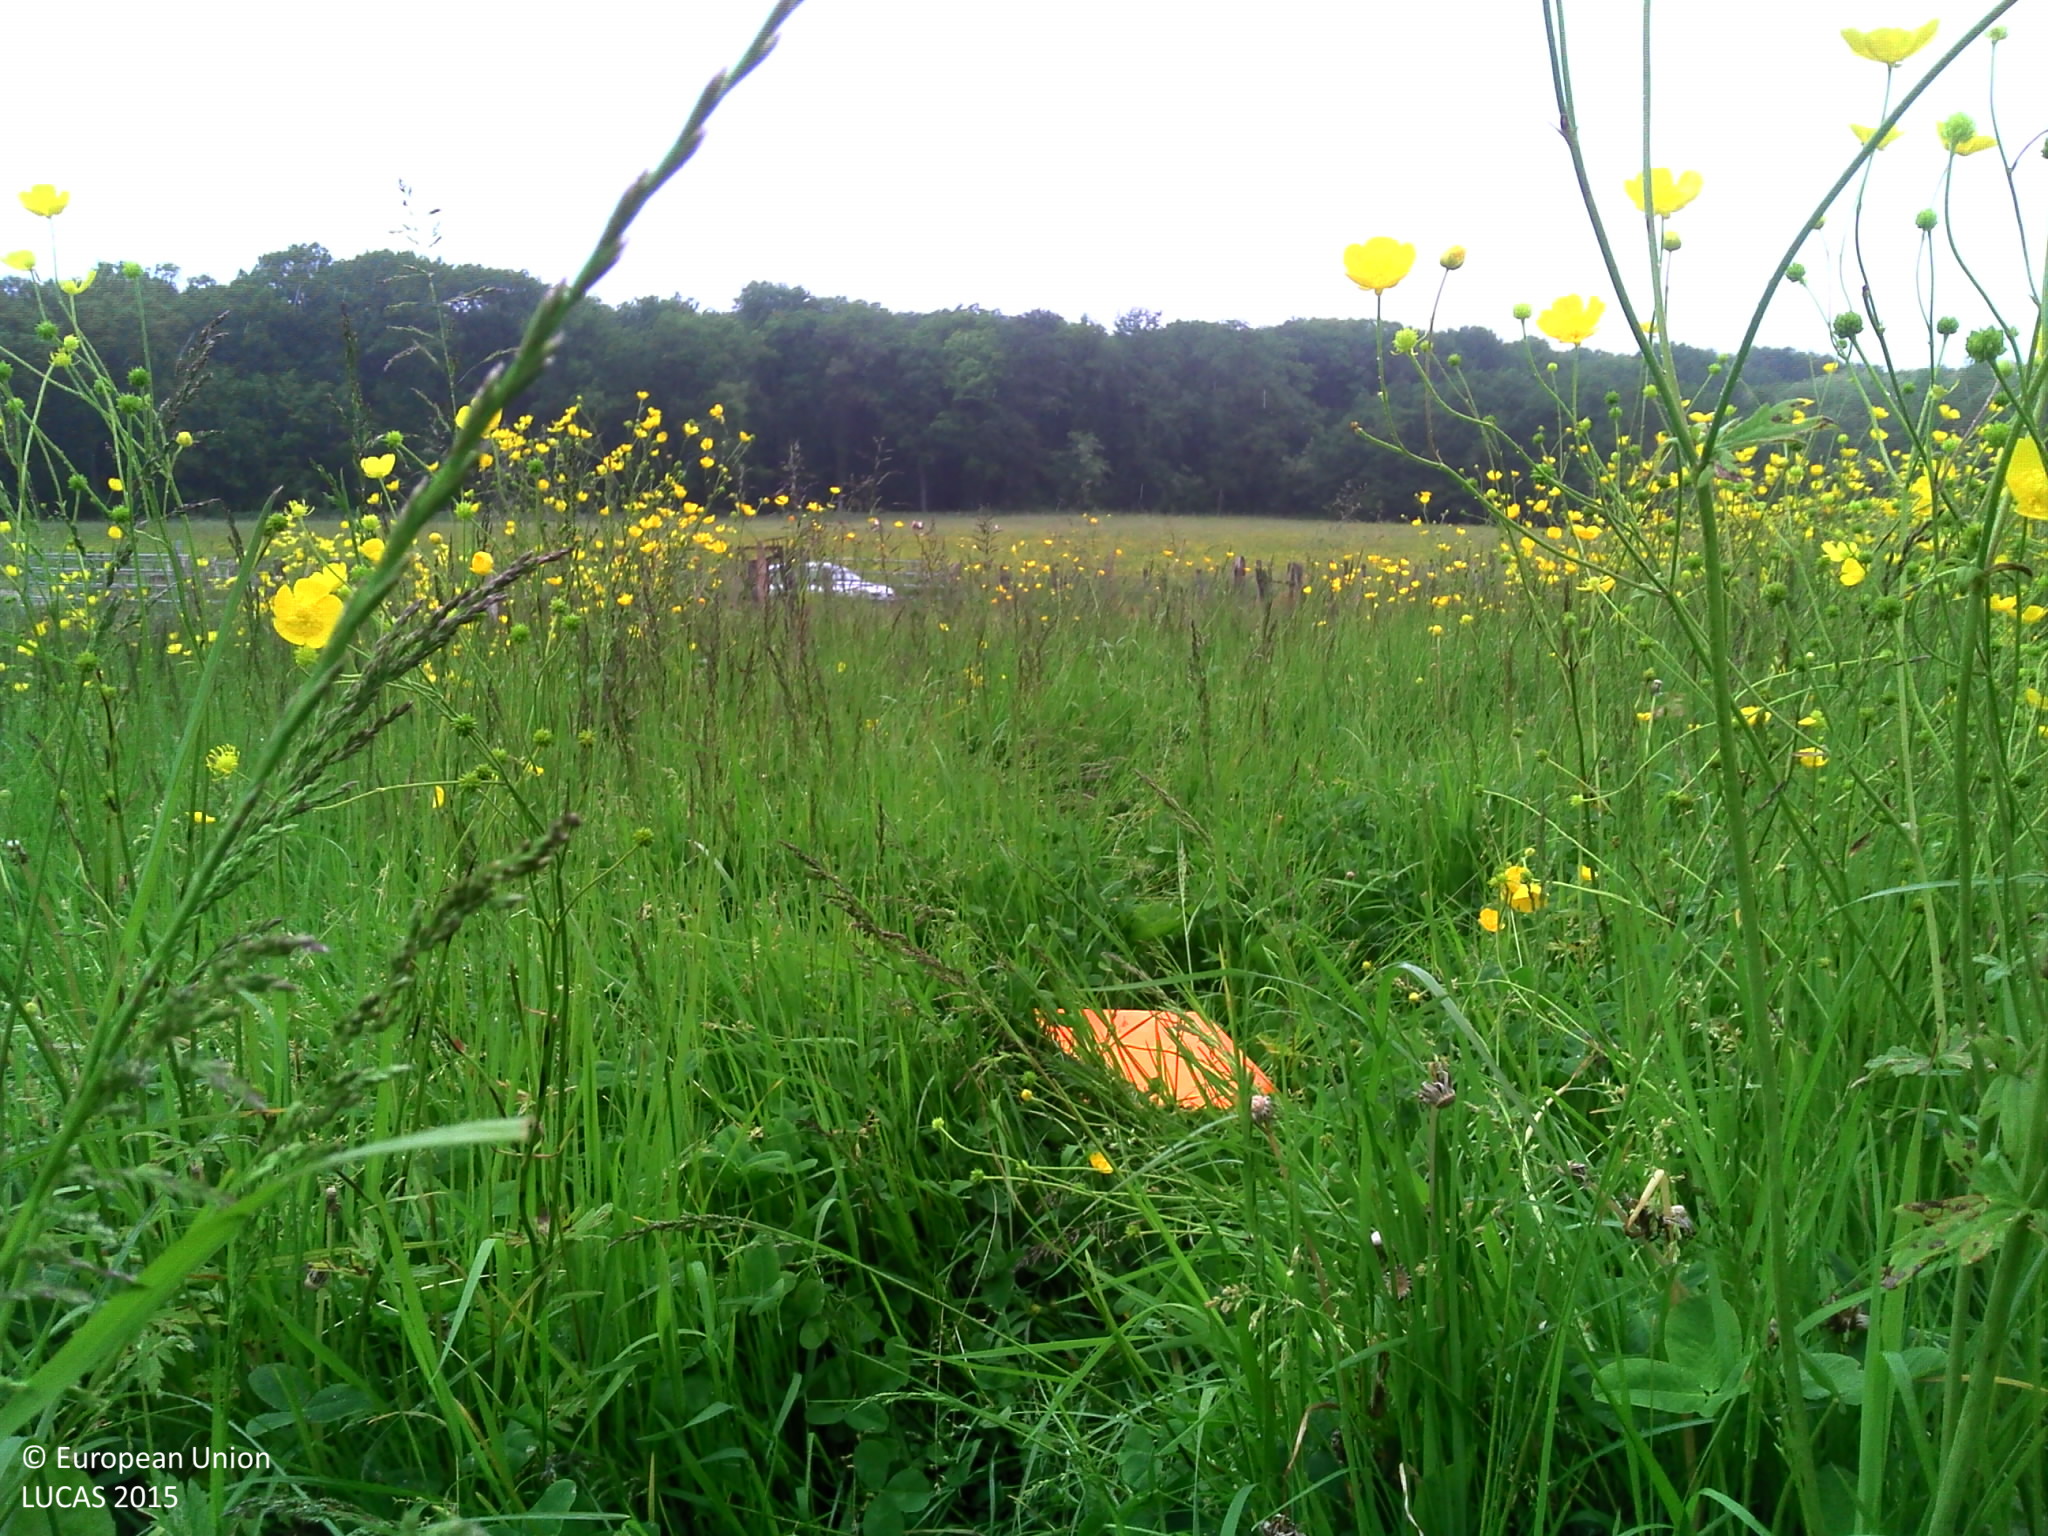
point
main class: Grassland
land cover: Grassland without tree/shrub cover
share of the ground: > 75 %
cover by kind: herbaceous plants 100 %
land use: Agriculture (excluding fallow land and kitchen gardens)
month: May
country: FR
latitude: 47.7920
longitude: 6.0362
